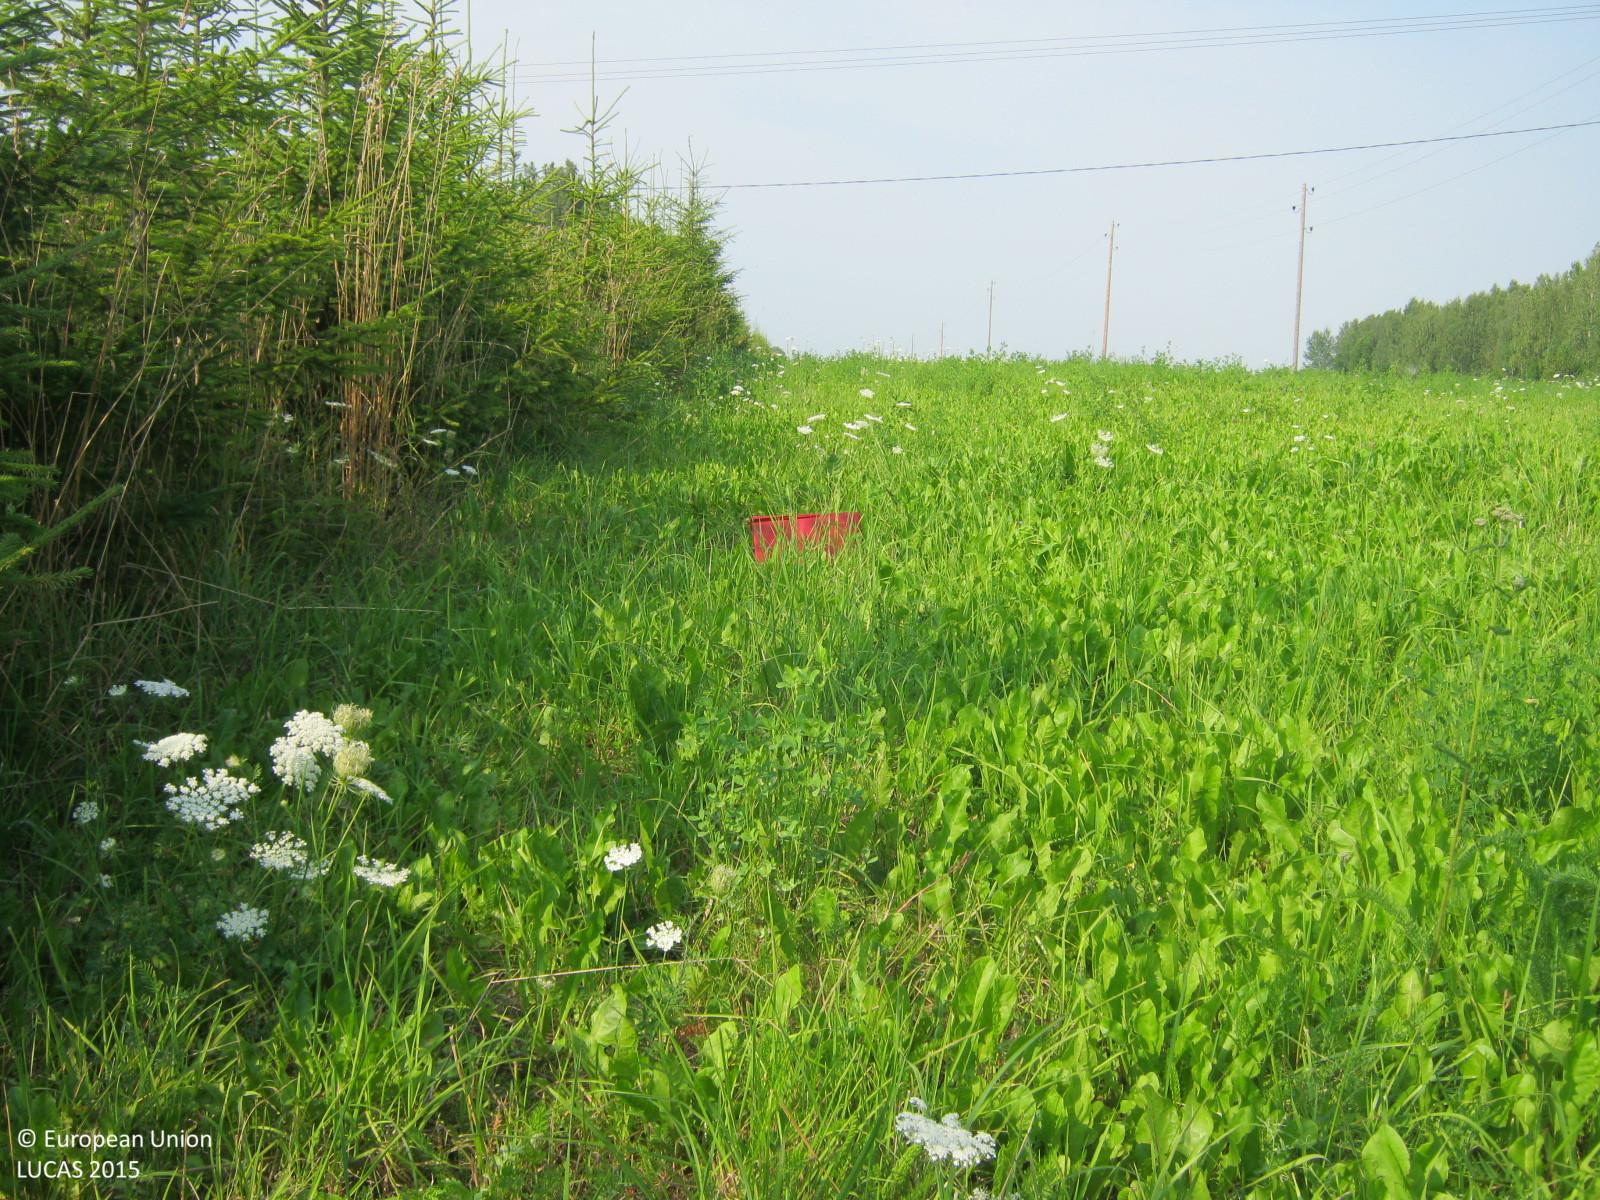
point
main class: Grassland
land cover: Grassland without tree/shrub cover
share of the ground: > 75 %
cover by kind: herbaceous plants 100 %
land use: Agriculture (excluding fallow land and kitchen gardens)
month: August
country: LV
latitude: 57.4346
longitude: 24.4319
